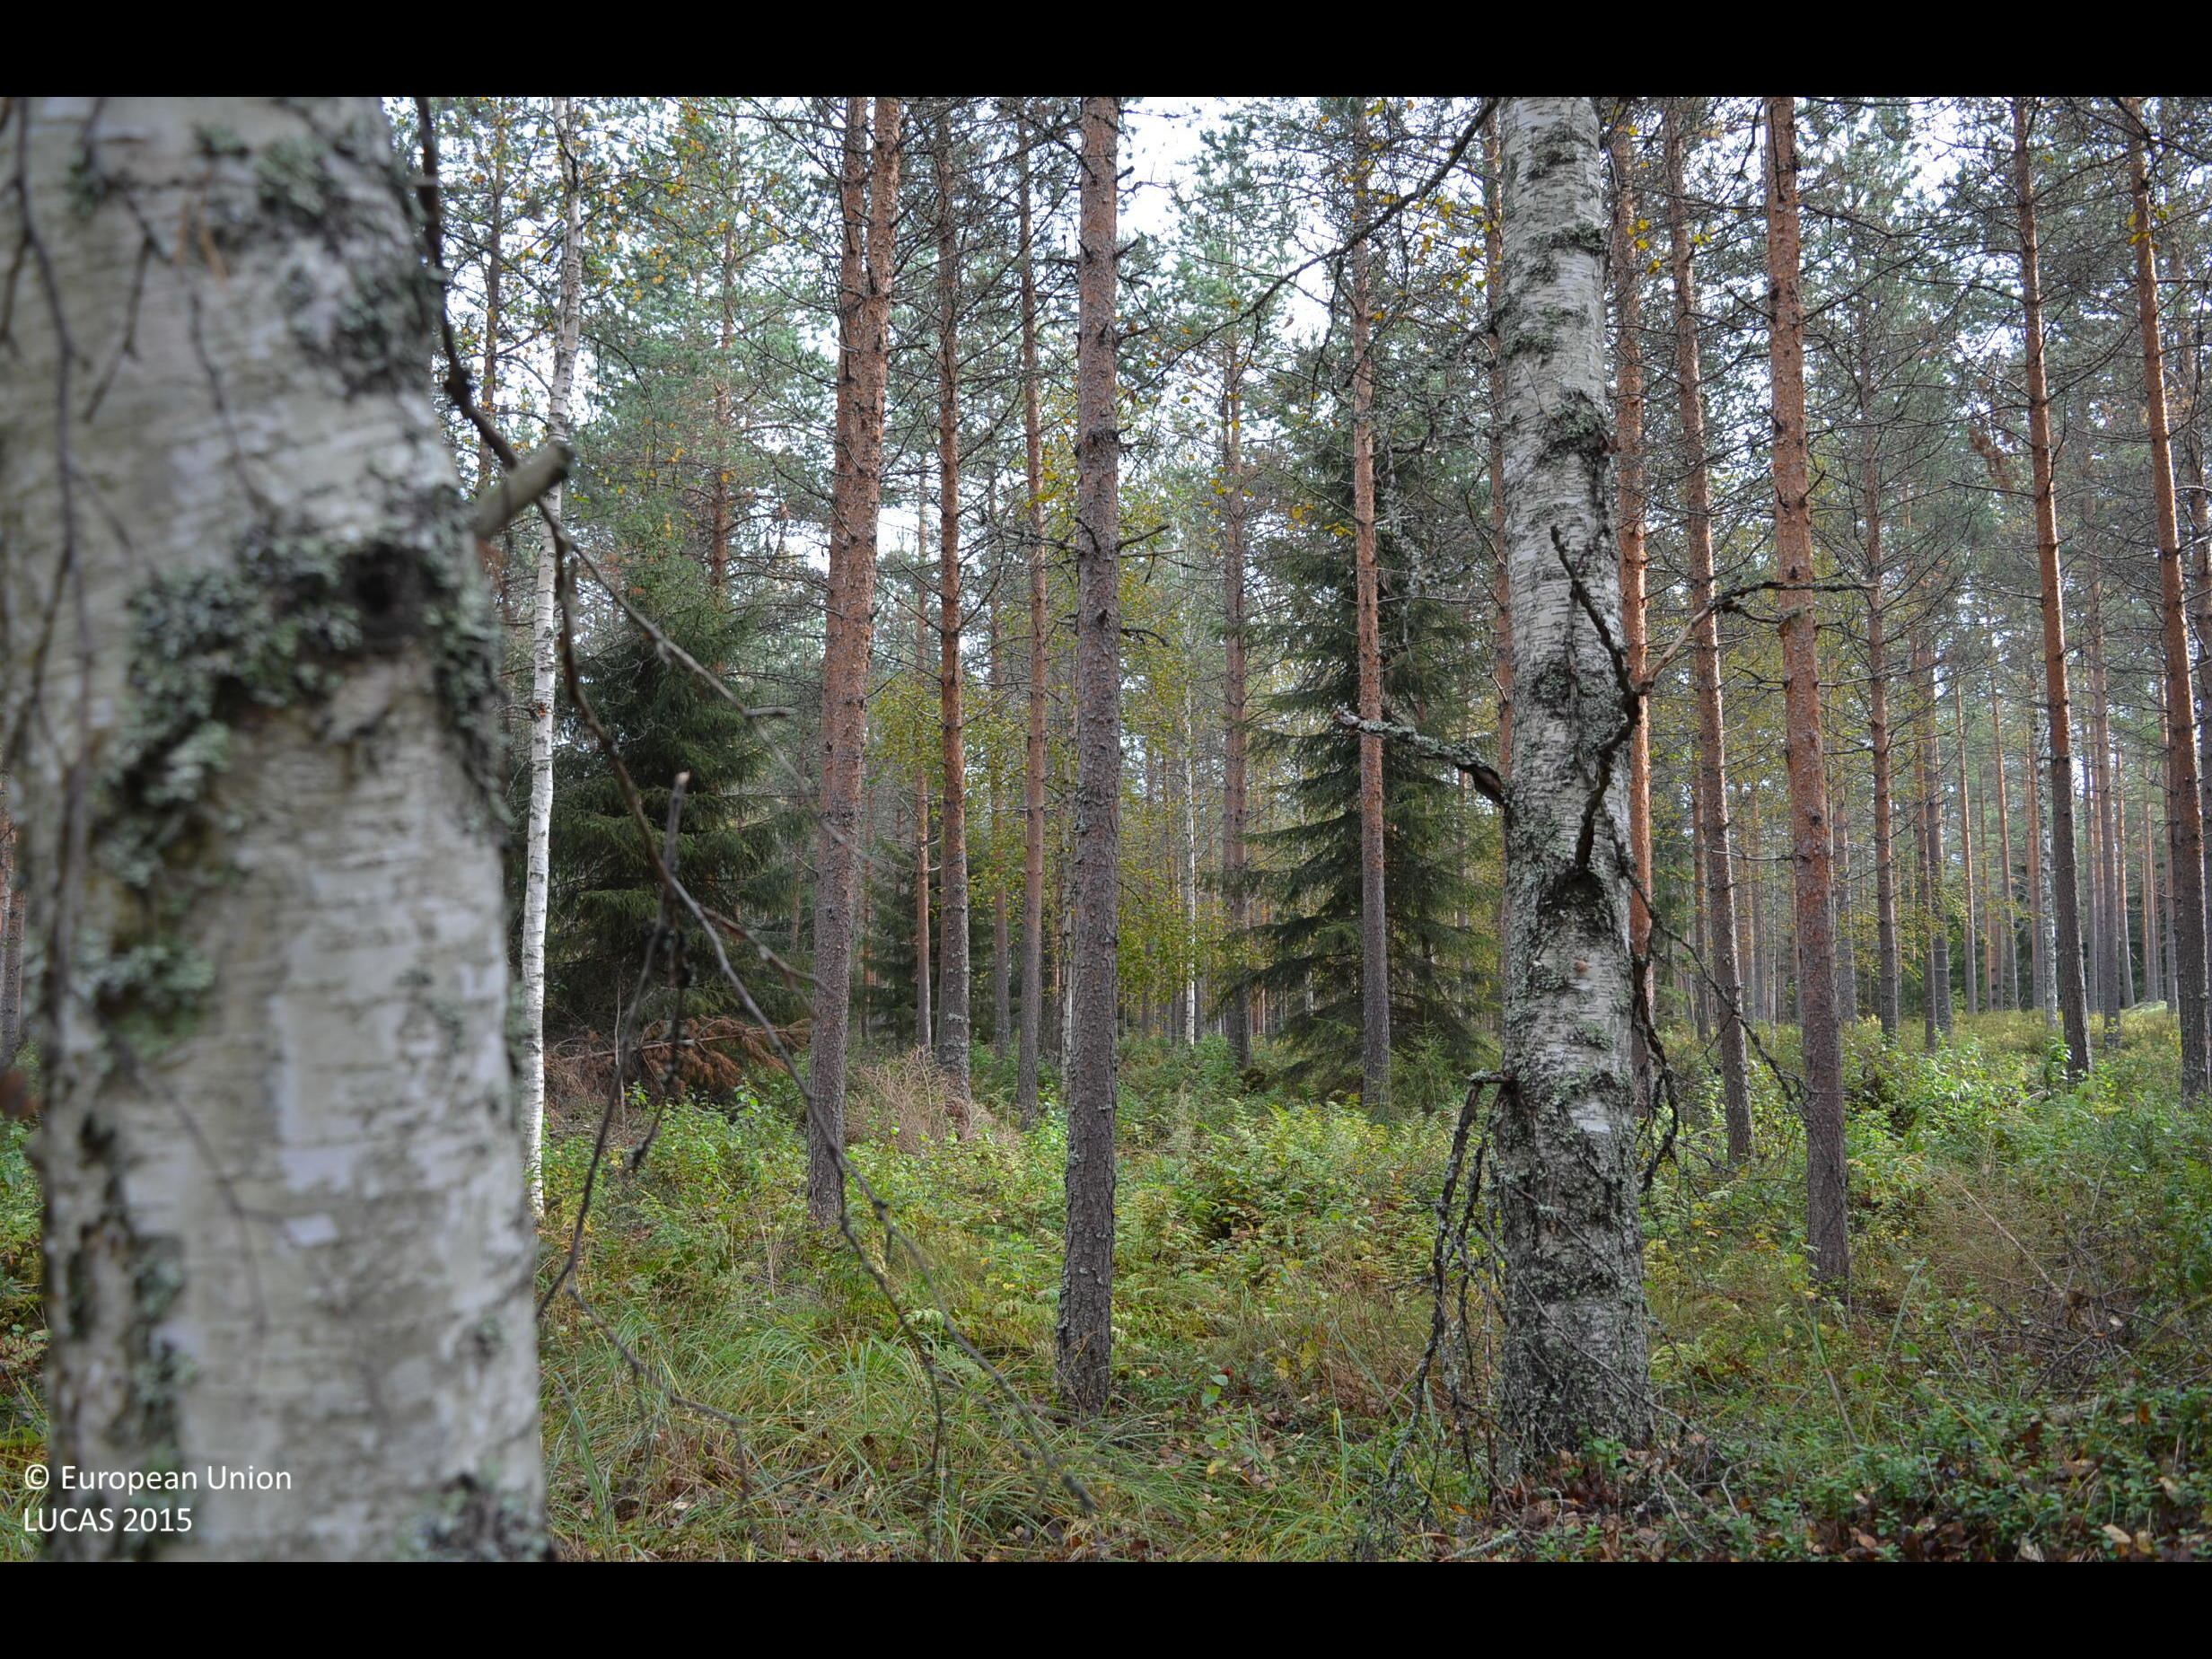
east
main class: Woodland
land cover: Pine dominated mixed woodland
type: boreal forest
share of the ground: > 75 %
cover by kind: coniferous forest trees 55 %, broadleaved forest trees 20 %, herbaceous plants 15 %, shrubs 10 %
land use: Forestry
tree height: > 5 m
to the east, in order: Pine dominated mixed woodland; Ditches and canals; Pine dominated mixed woodland; Ditches and canals; Pine dominated mixed woodland; Spruce dominated mixed woodland; Pine dominated mixed woodland; Pine dominated coniferous woodland; Other mixed woodland; Ditches and canals
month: September
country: FI
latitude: 62.6951
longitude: 23.7320
